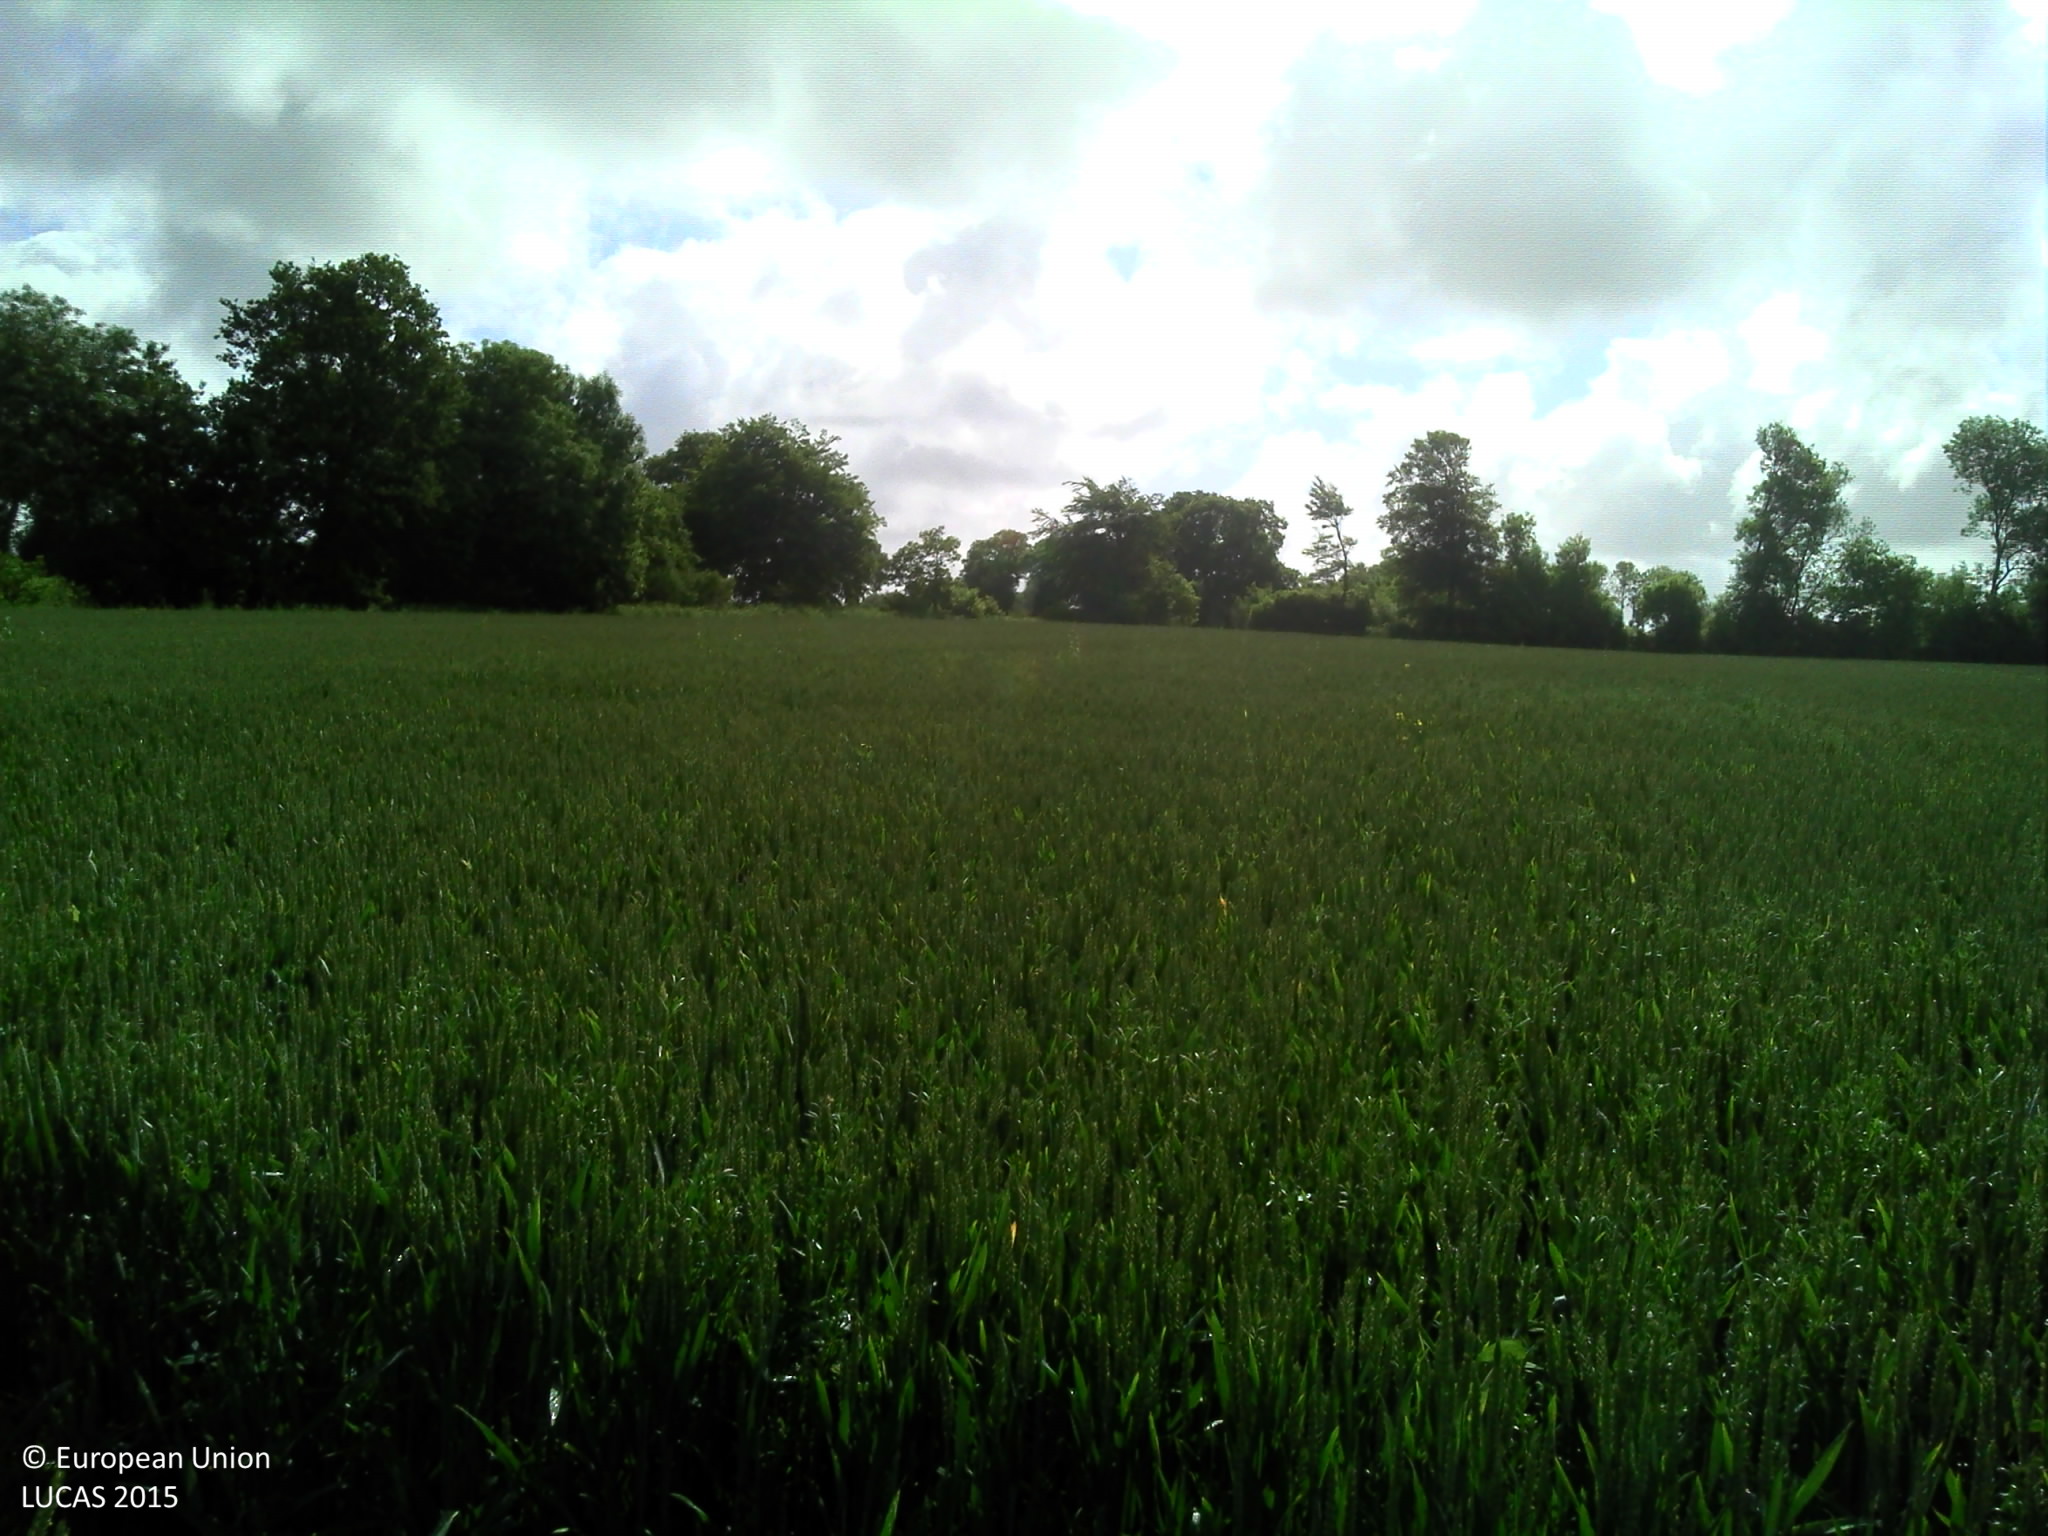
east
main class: Cropland
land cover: Common wheat
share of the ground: > 75 %
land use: Agriculture (excluding fallow land and kitchen gardens)
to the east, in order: Common wheat; Abandoned hedges; Tracks; Abandoned hedges; Common wheat; Broadleaved woodland; Barley
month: June
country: FR
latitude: 49.5577
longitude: -1.7343
